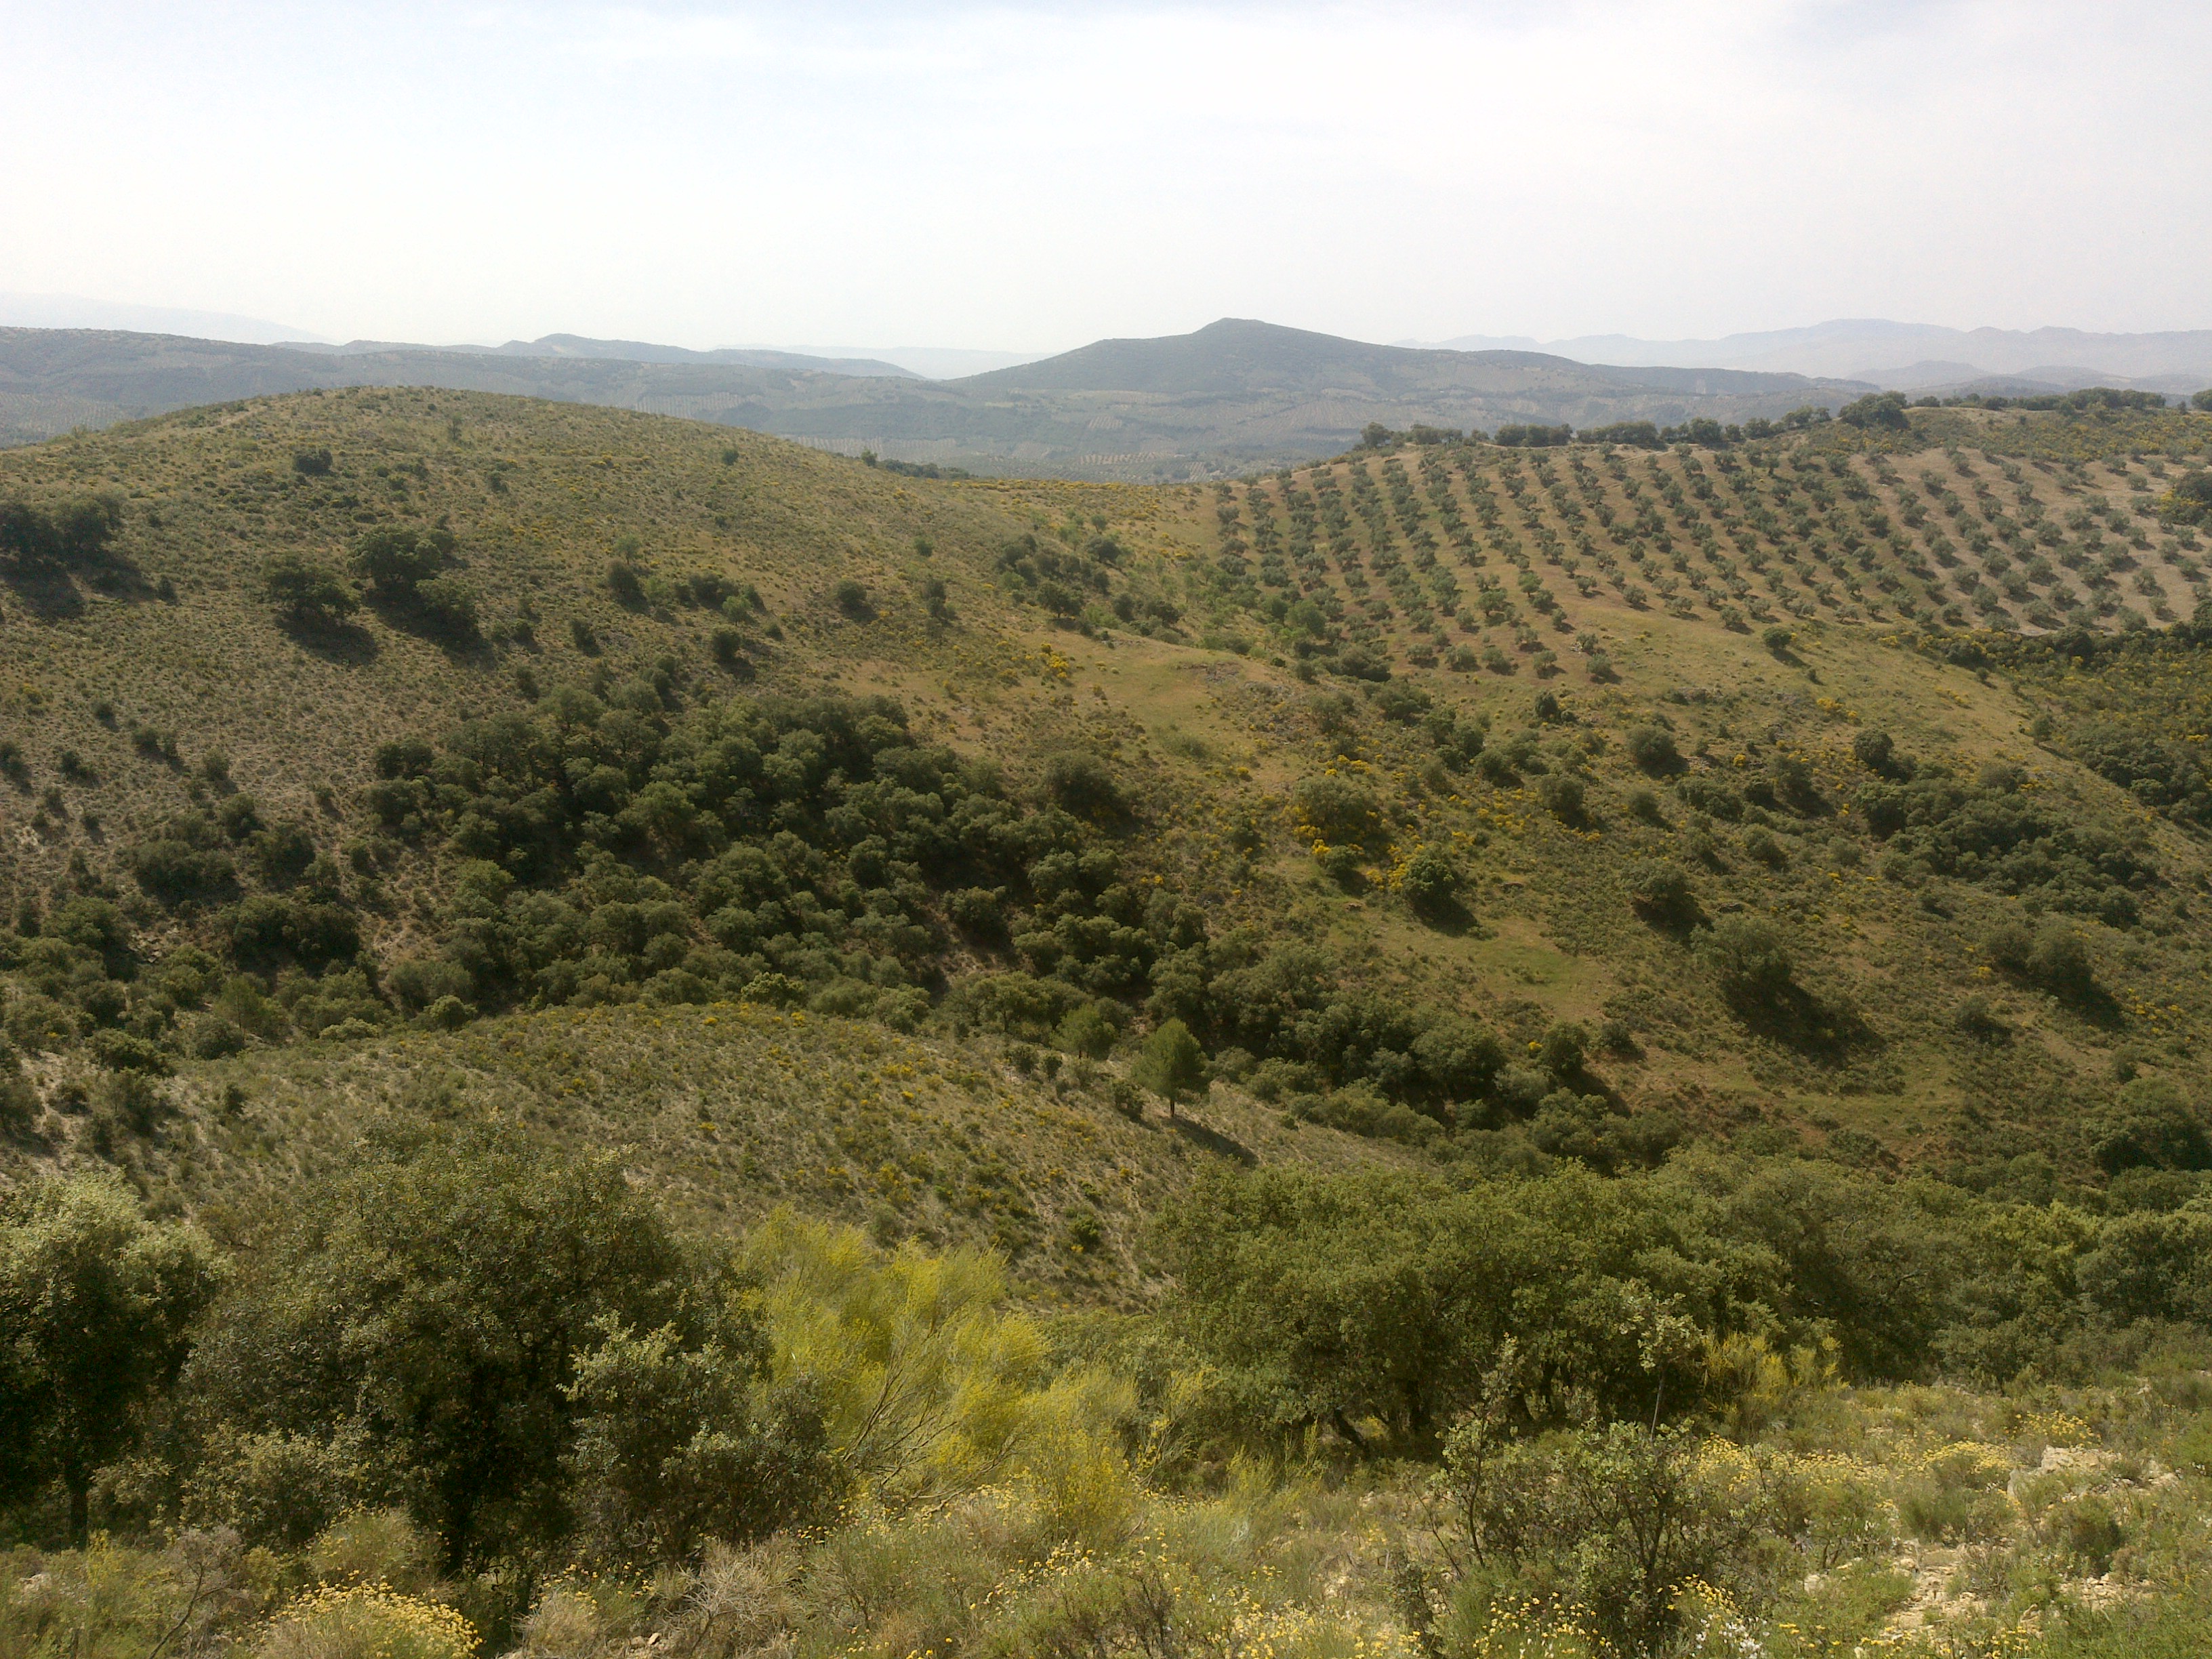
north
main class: Shrubland
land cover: Shrubland with sparse tree cover
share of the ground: 25 - 50 %
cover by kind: shrubs 40 %, unconsolidated bare surface 35 %, herbaceous plants 20 %, broadleaved forest trees 5 %
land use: Semi-natural and natural areas not in use
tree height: < 5 m
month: May
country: ES
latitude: 37.3788
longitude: -4.1715
